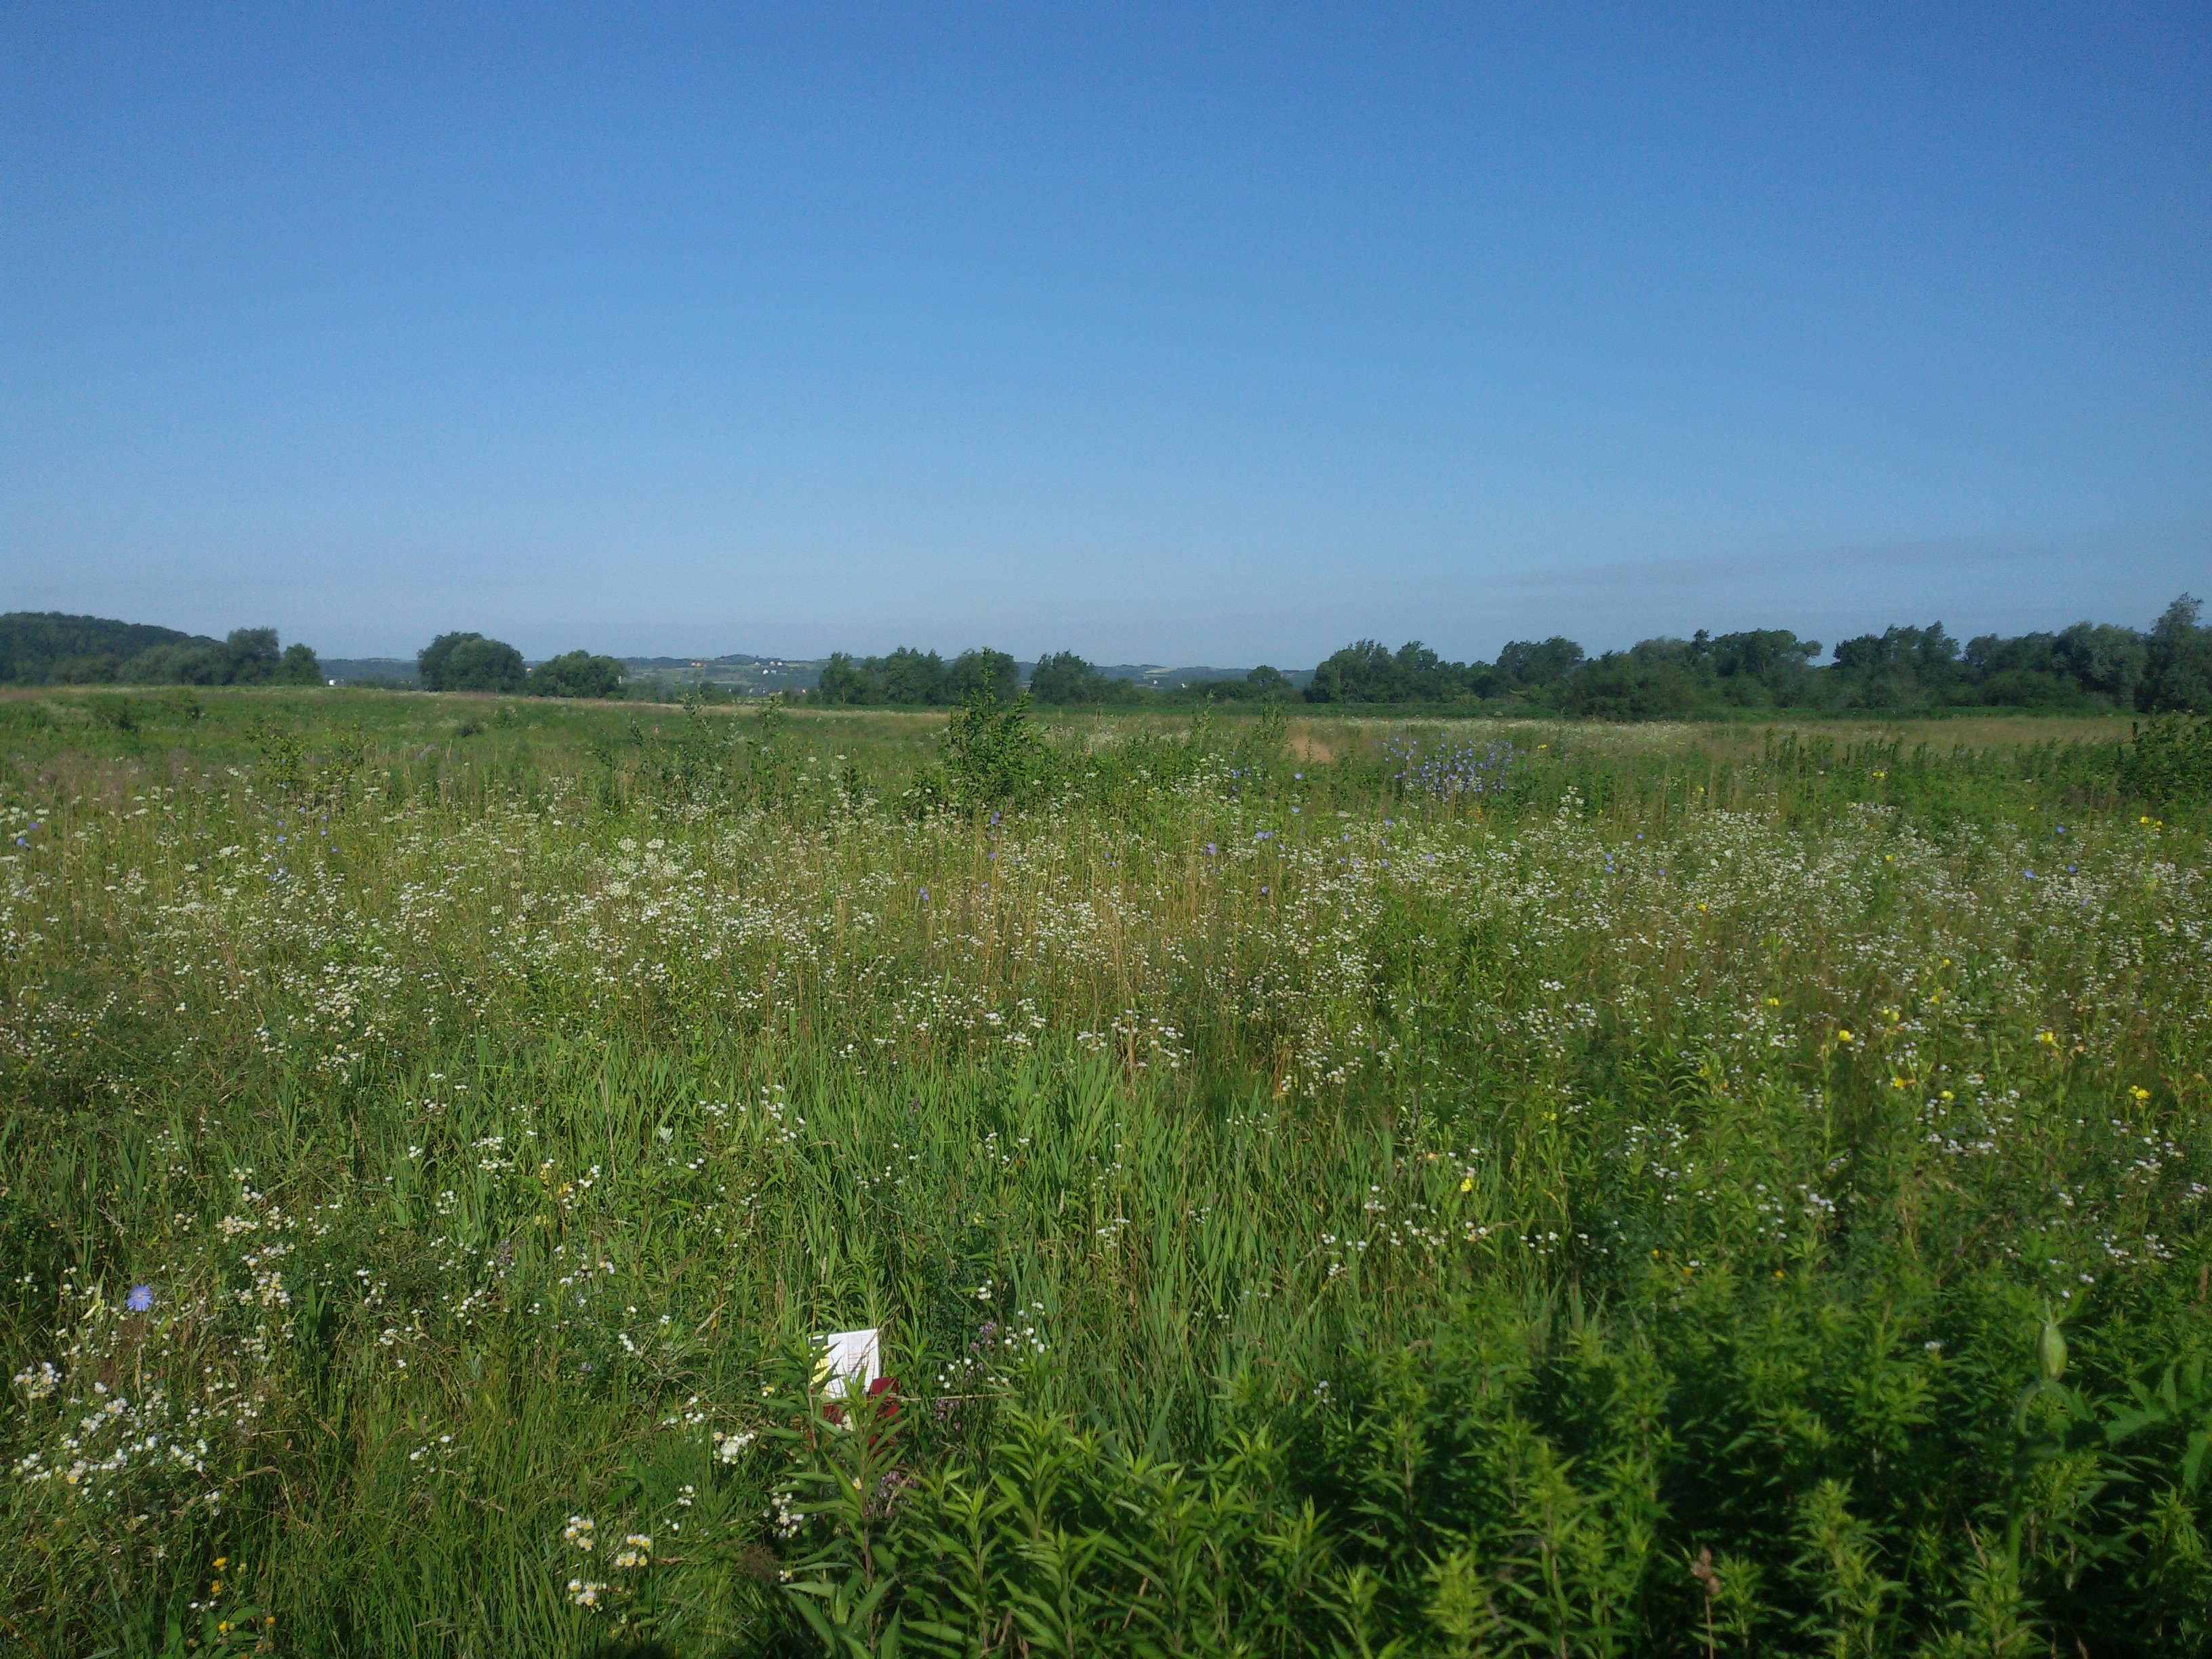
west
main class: Grassland
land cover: Spontaneously vegetated surfaces
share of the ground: > 75 %
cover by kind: herbaceous plants 100 %
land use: Semi-natural and natural areas not in use
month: July
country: PL
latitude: 49.8266
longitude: 22.2804
